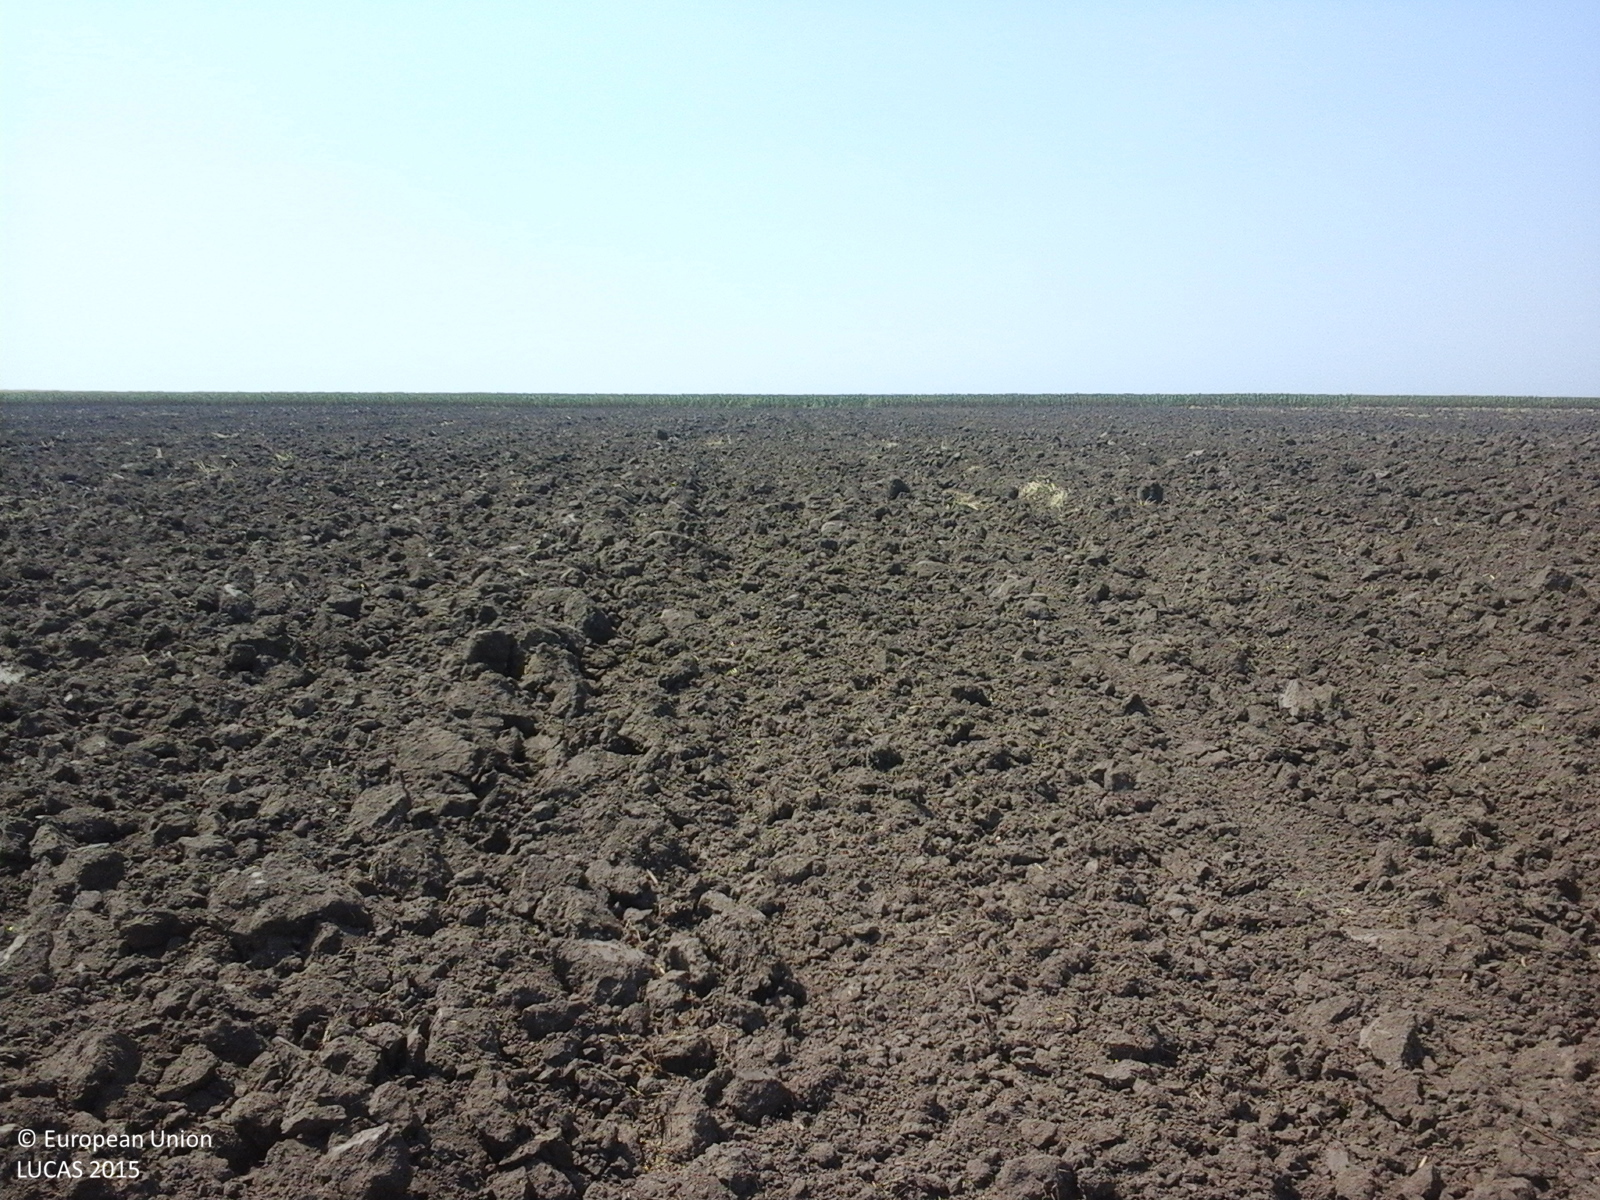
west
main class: Cropland
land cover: Common wheat
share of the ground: < 10 %
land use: Agriculture (excluding fallow land and kitchen gardens)
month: July
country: RO
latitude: 45.9207
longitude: 27.5266
